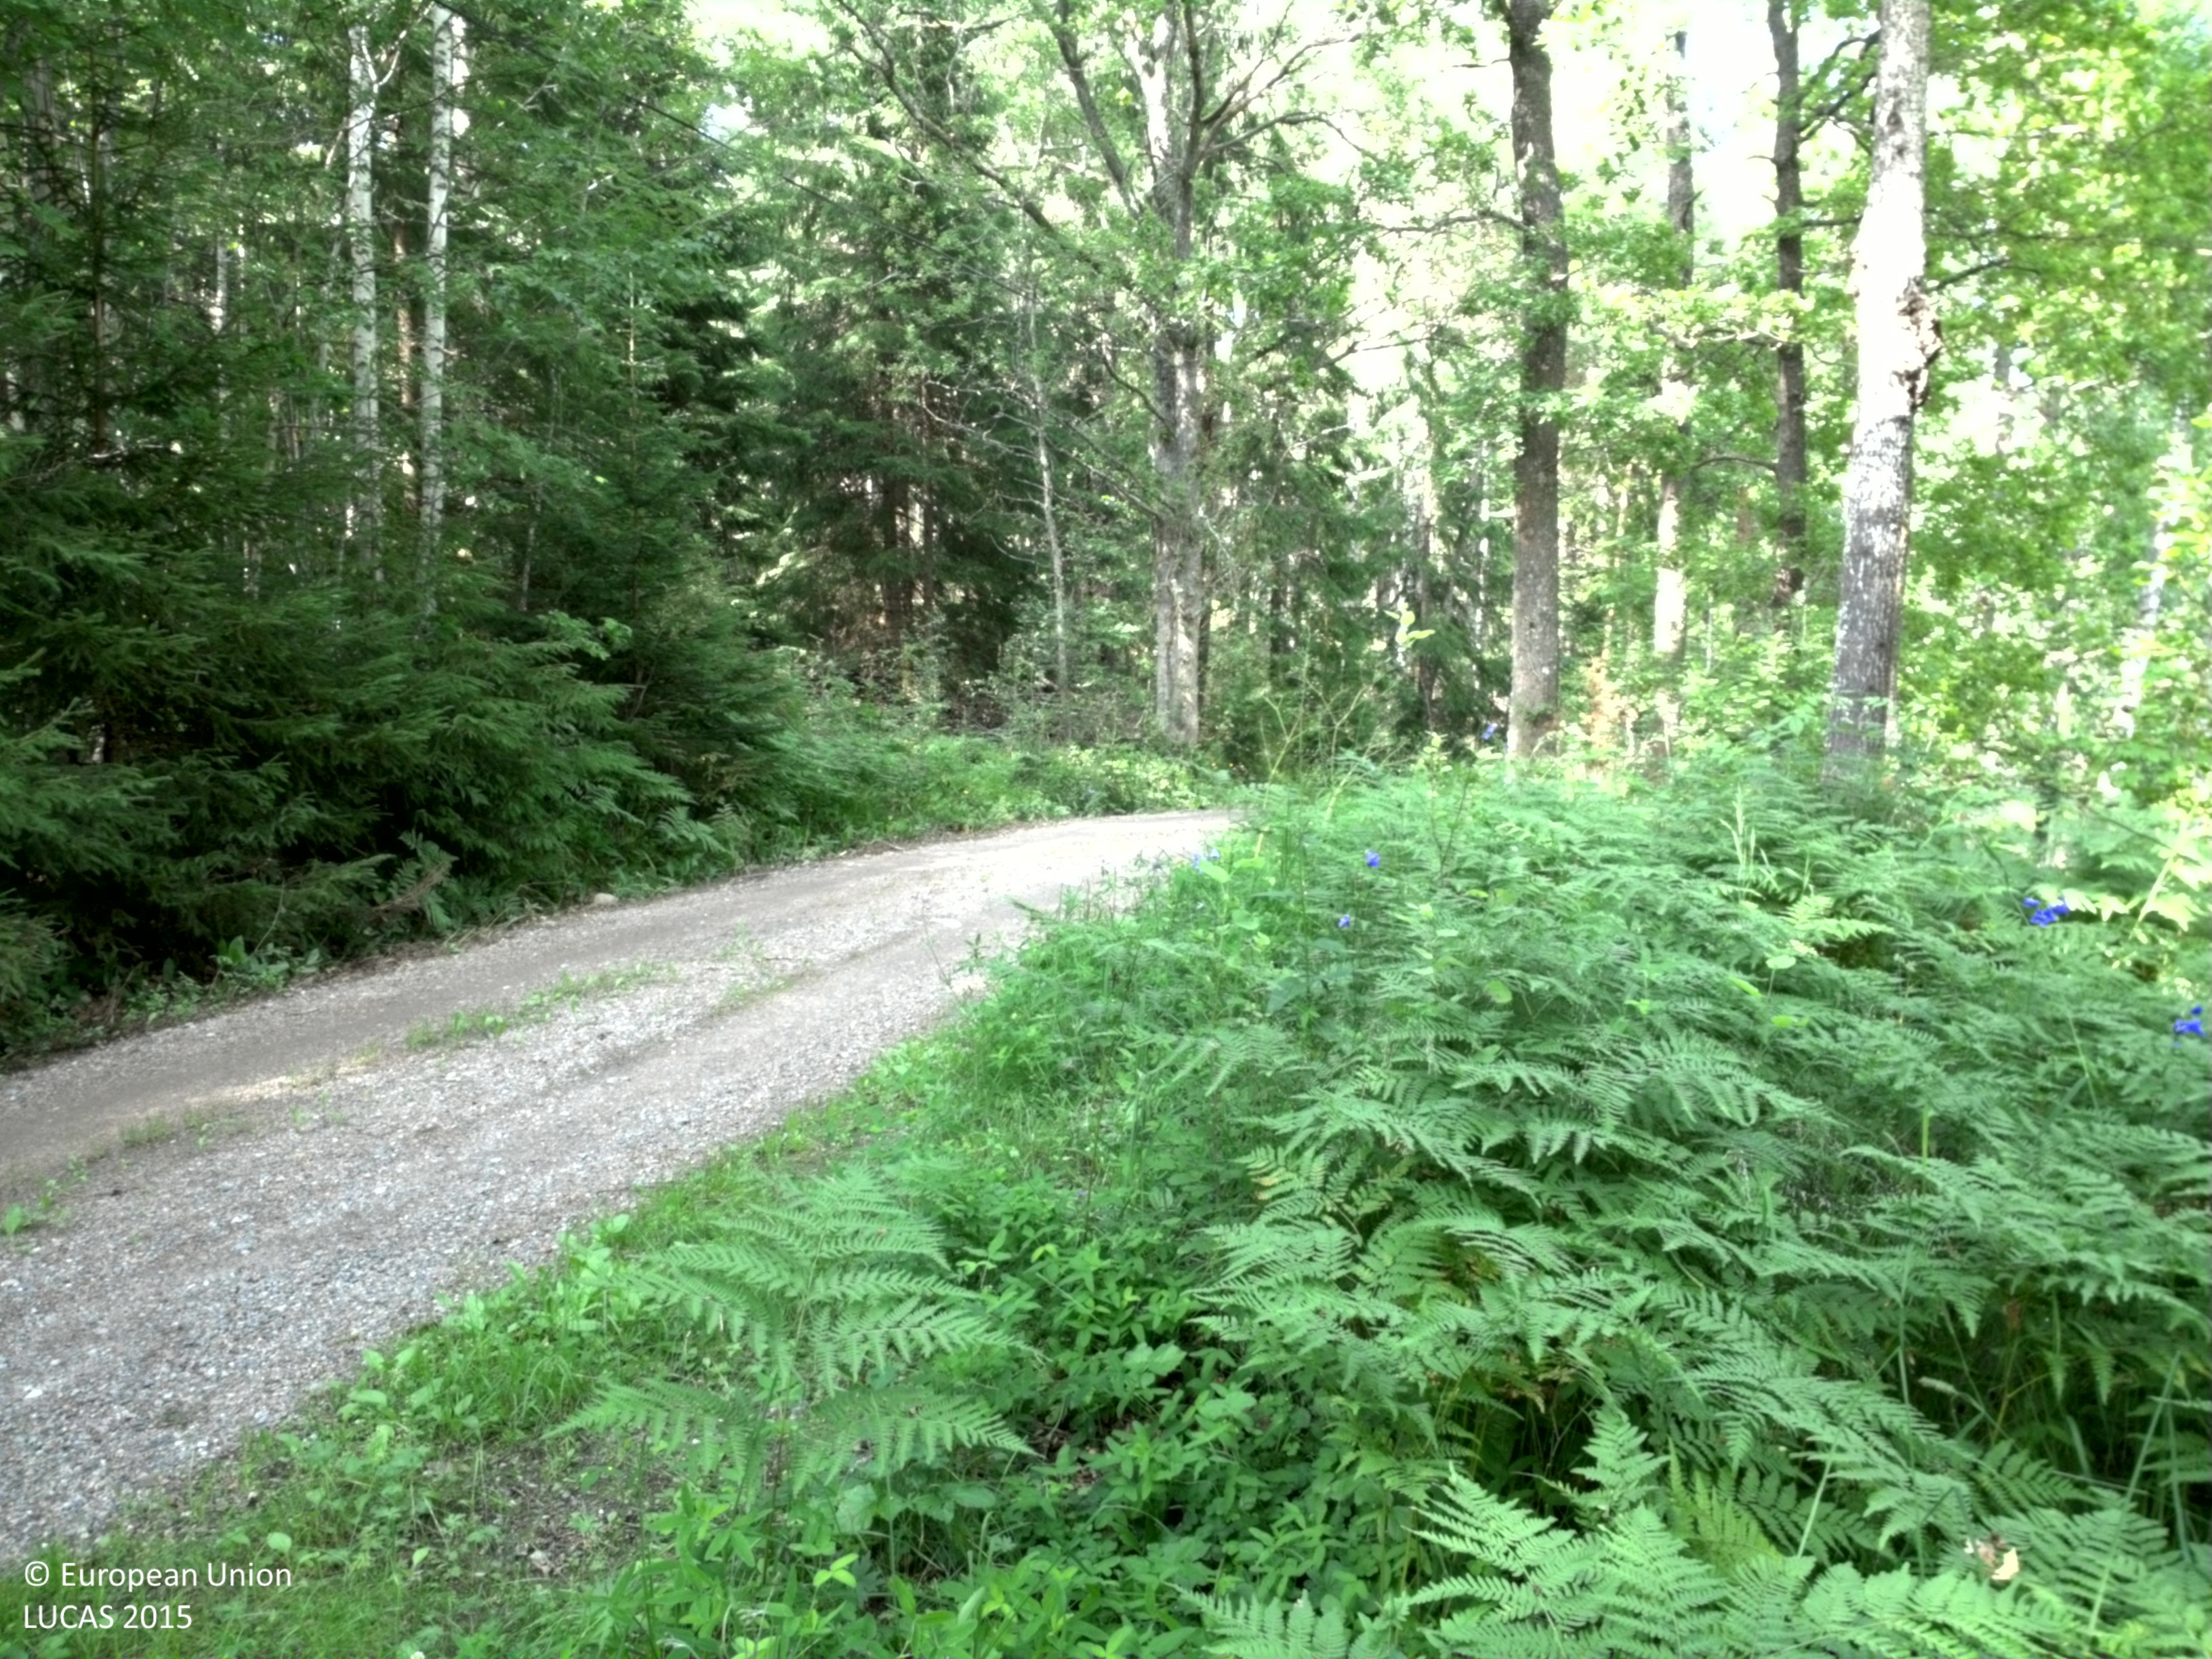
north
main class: Woodland
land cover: Broadleaved woodland
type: hemiboreal forest and nemoral coniferous forest and mixed broadleaved-coniferous forest
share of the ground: 50 - 75 %
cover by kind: broadleaved forest trees 60 %, herbaceous plants 40 %
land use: Forestry
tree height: > 5 m
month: July
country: SE
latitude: 58.7587
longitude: 15.4386
